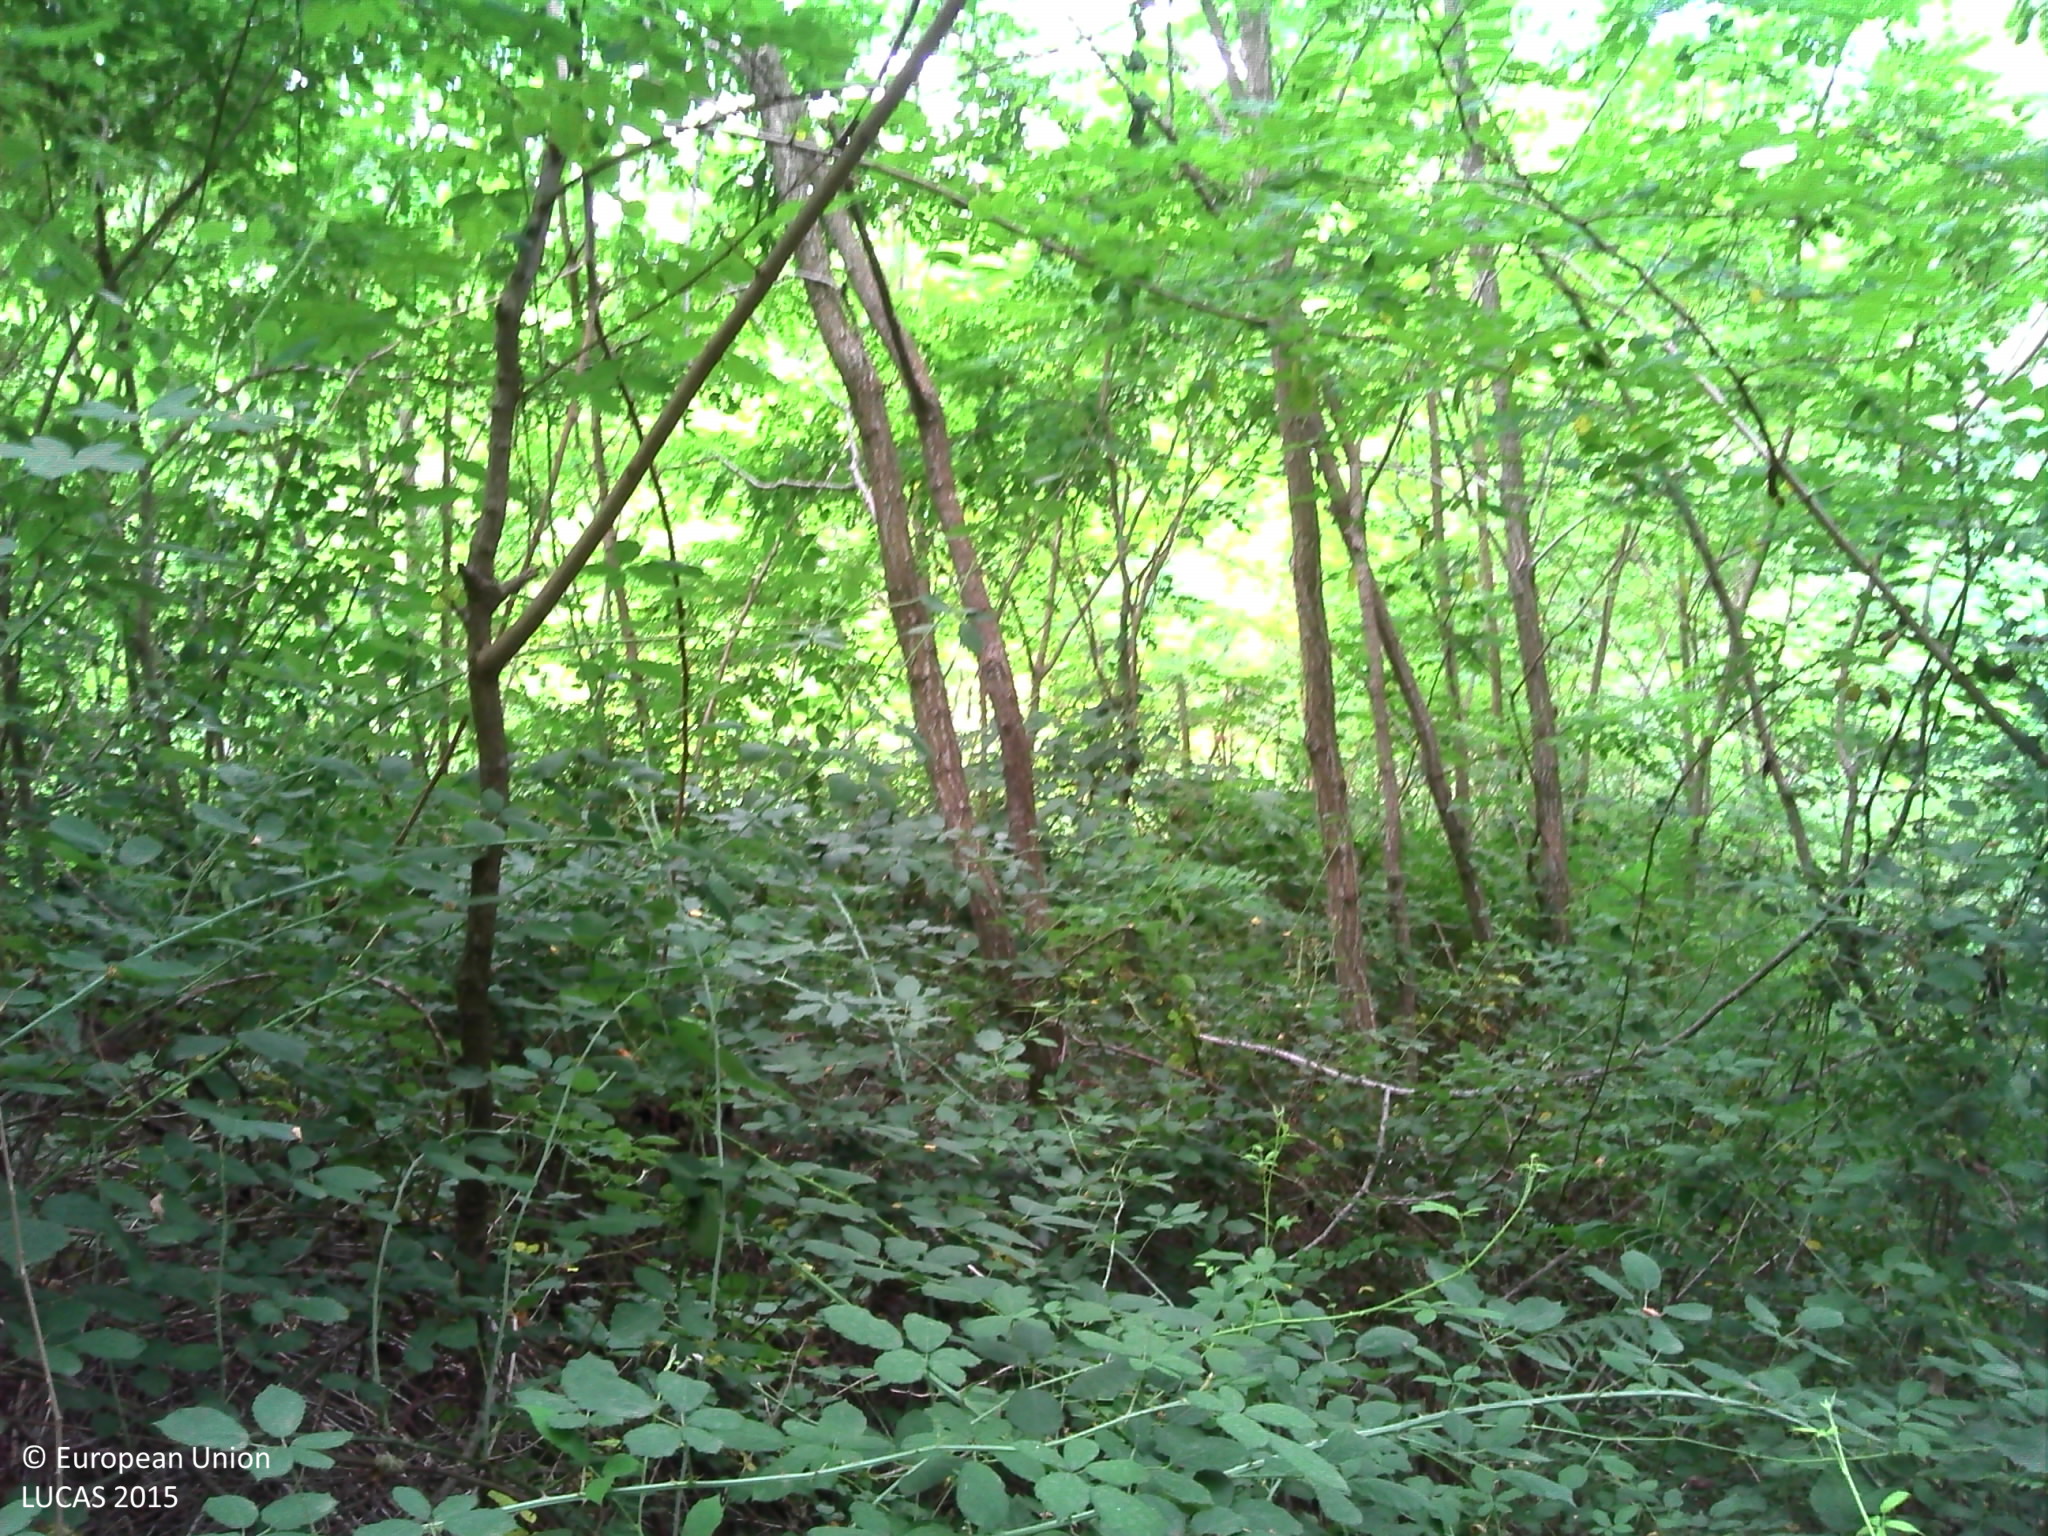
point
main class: Woodland
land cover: Pine dominated mixed woodland
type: coniferous forest of the mediterranean region
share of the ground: > 75 %
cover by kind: coniferous forest trees 30 %, broadleaved forest trees 30 %, shrubs 20 %, herbaceous plants 20 %
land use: Forestry
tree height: > 5 m
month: July
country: FR
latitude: 44.9703
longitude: 0.5439
